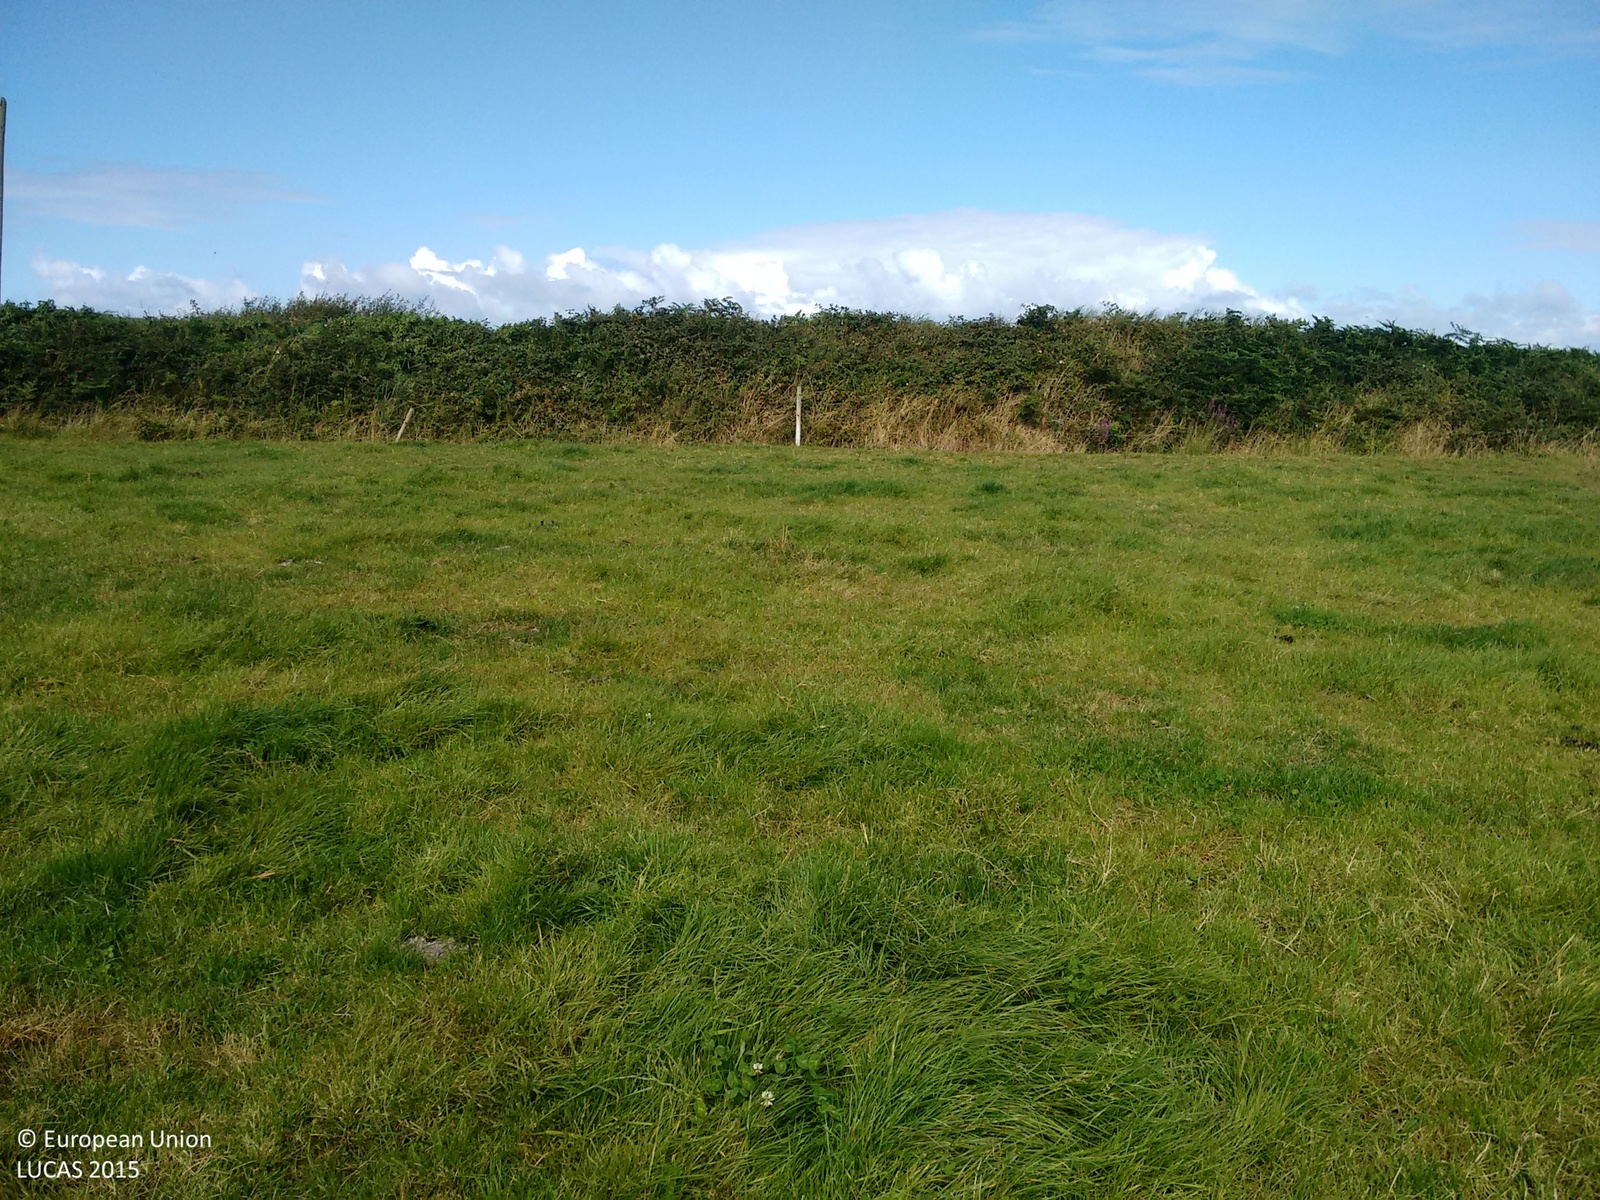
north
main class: Grassland
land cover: Grassland without tree/shrub cover
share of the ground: > 75 %
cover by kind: herbaceous plants 100 %
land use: Agriculture (excluding fallow land and kitchen gardens)
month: September
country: IE
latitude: 52.3950
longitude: -9.7752
